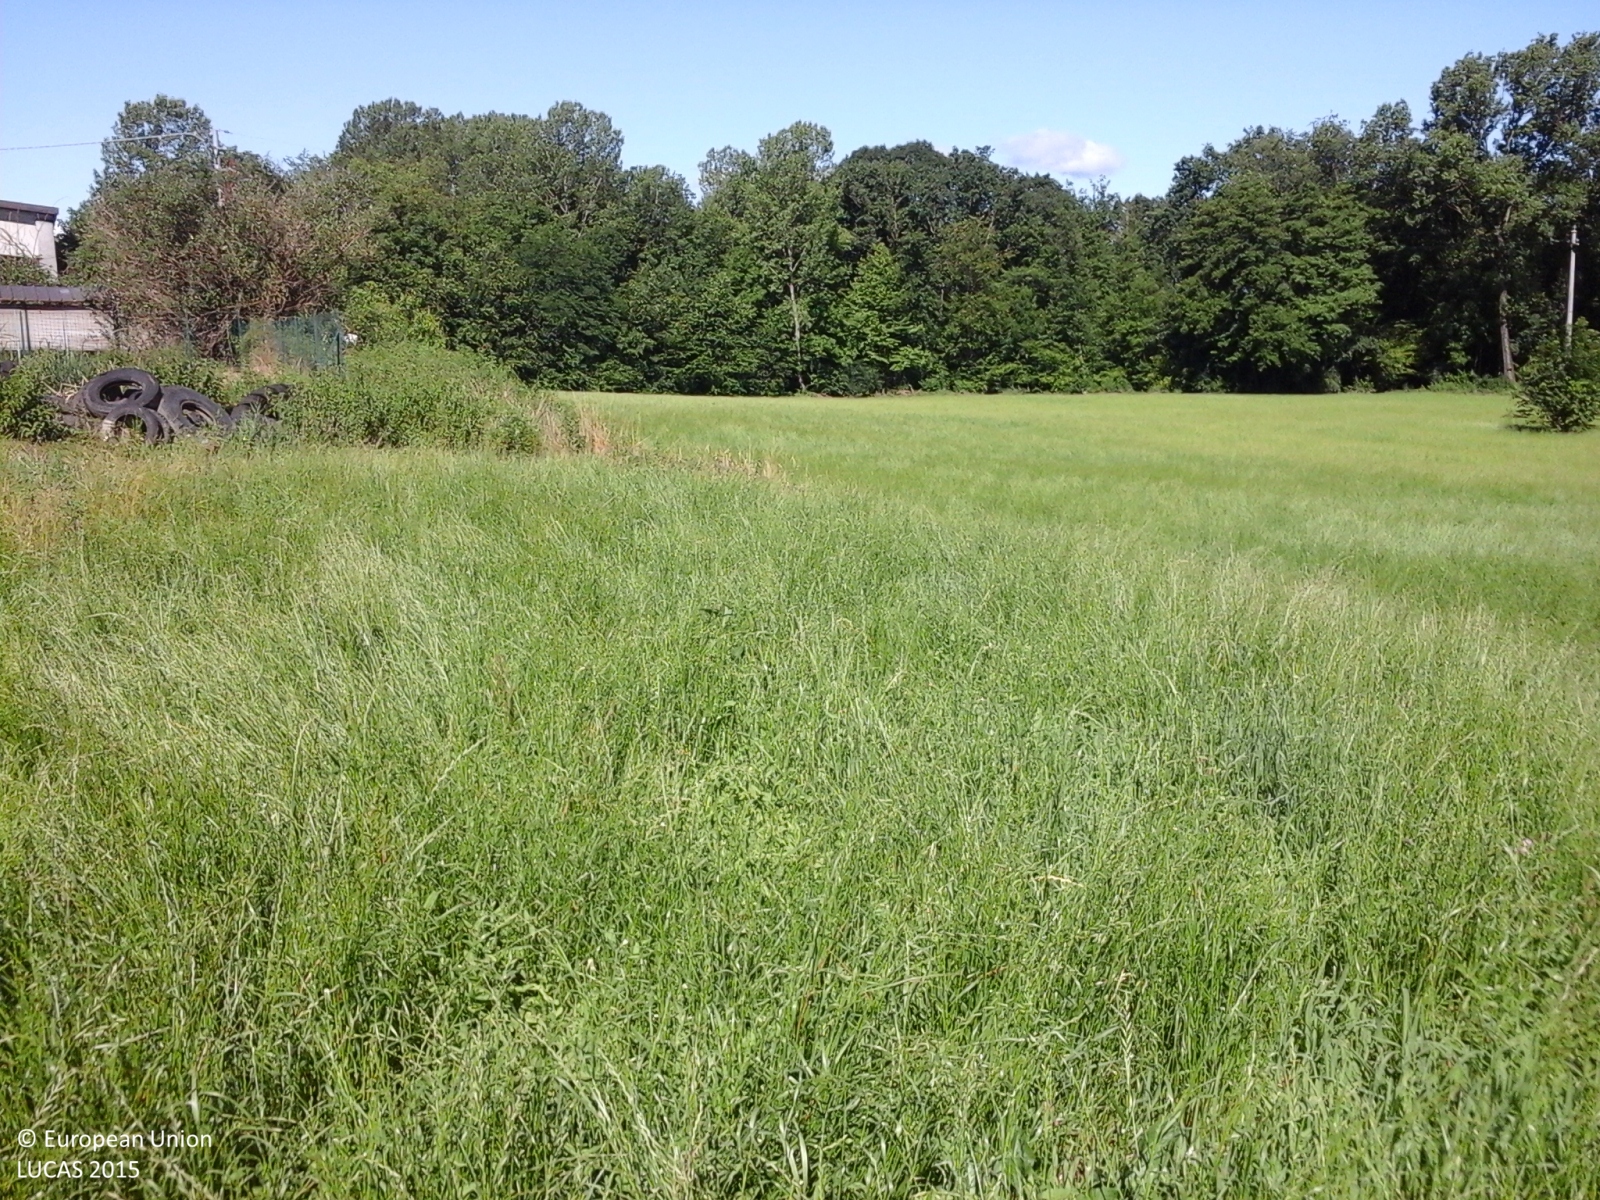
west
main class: Grassland
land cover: Grassland without tree/shrub cover
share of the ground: > 75 %
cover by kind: herbaceous plants 100 %
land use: Agriculture (excluding fallow land and kitchen gardens)
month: June
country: IT
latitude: 45.7838
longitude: 8.6258
